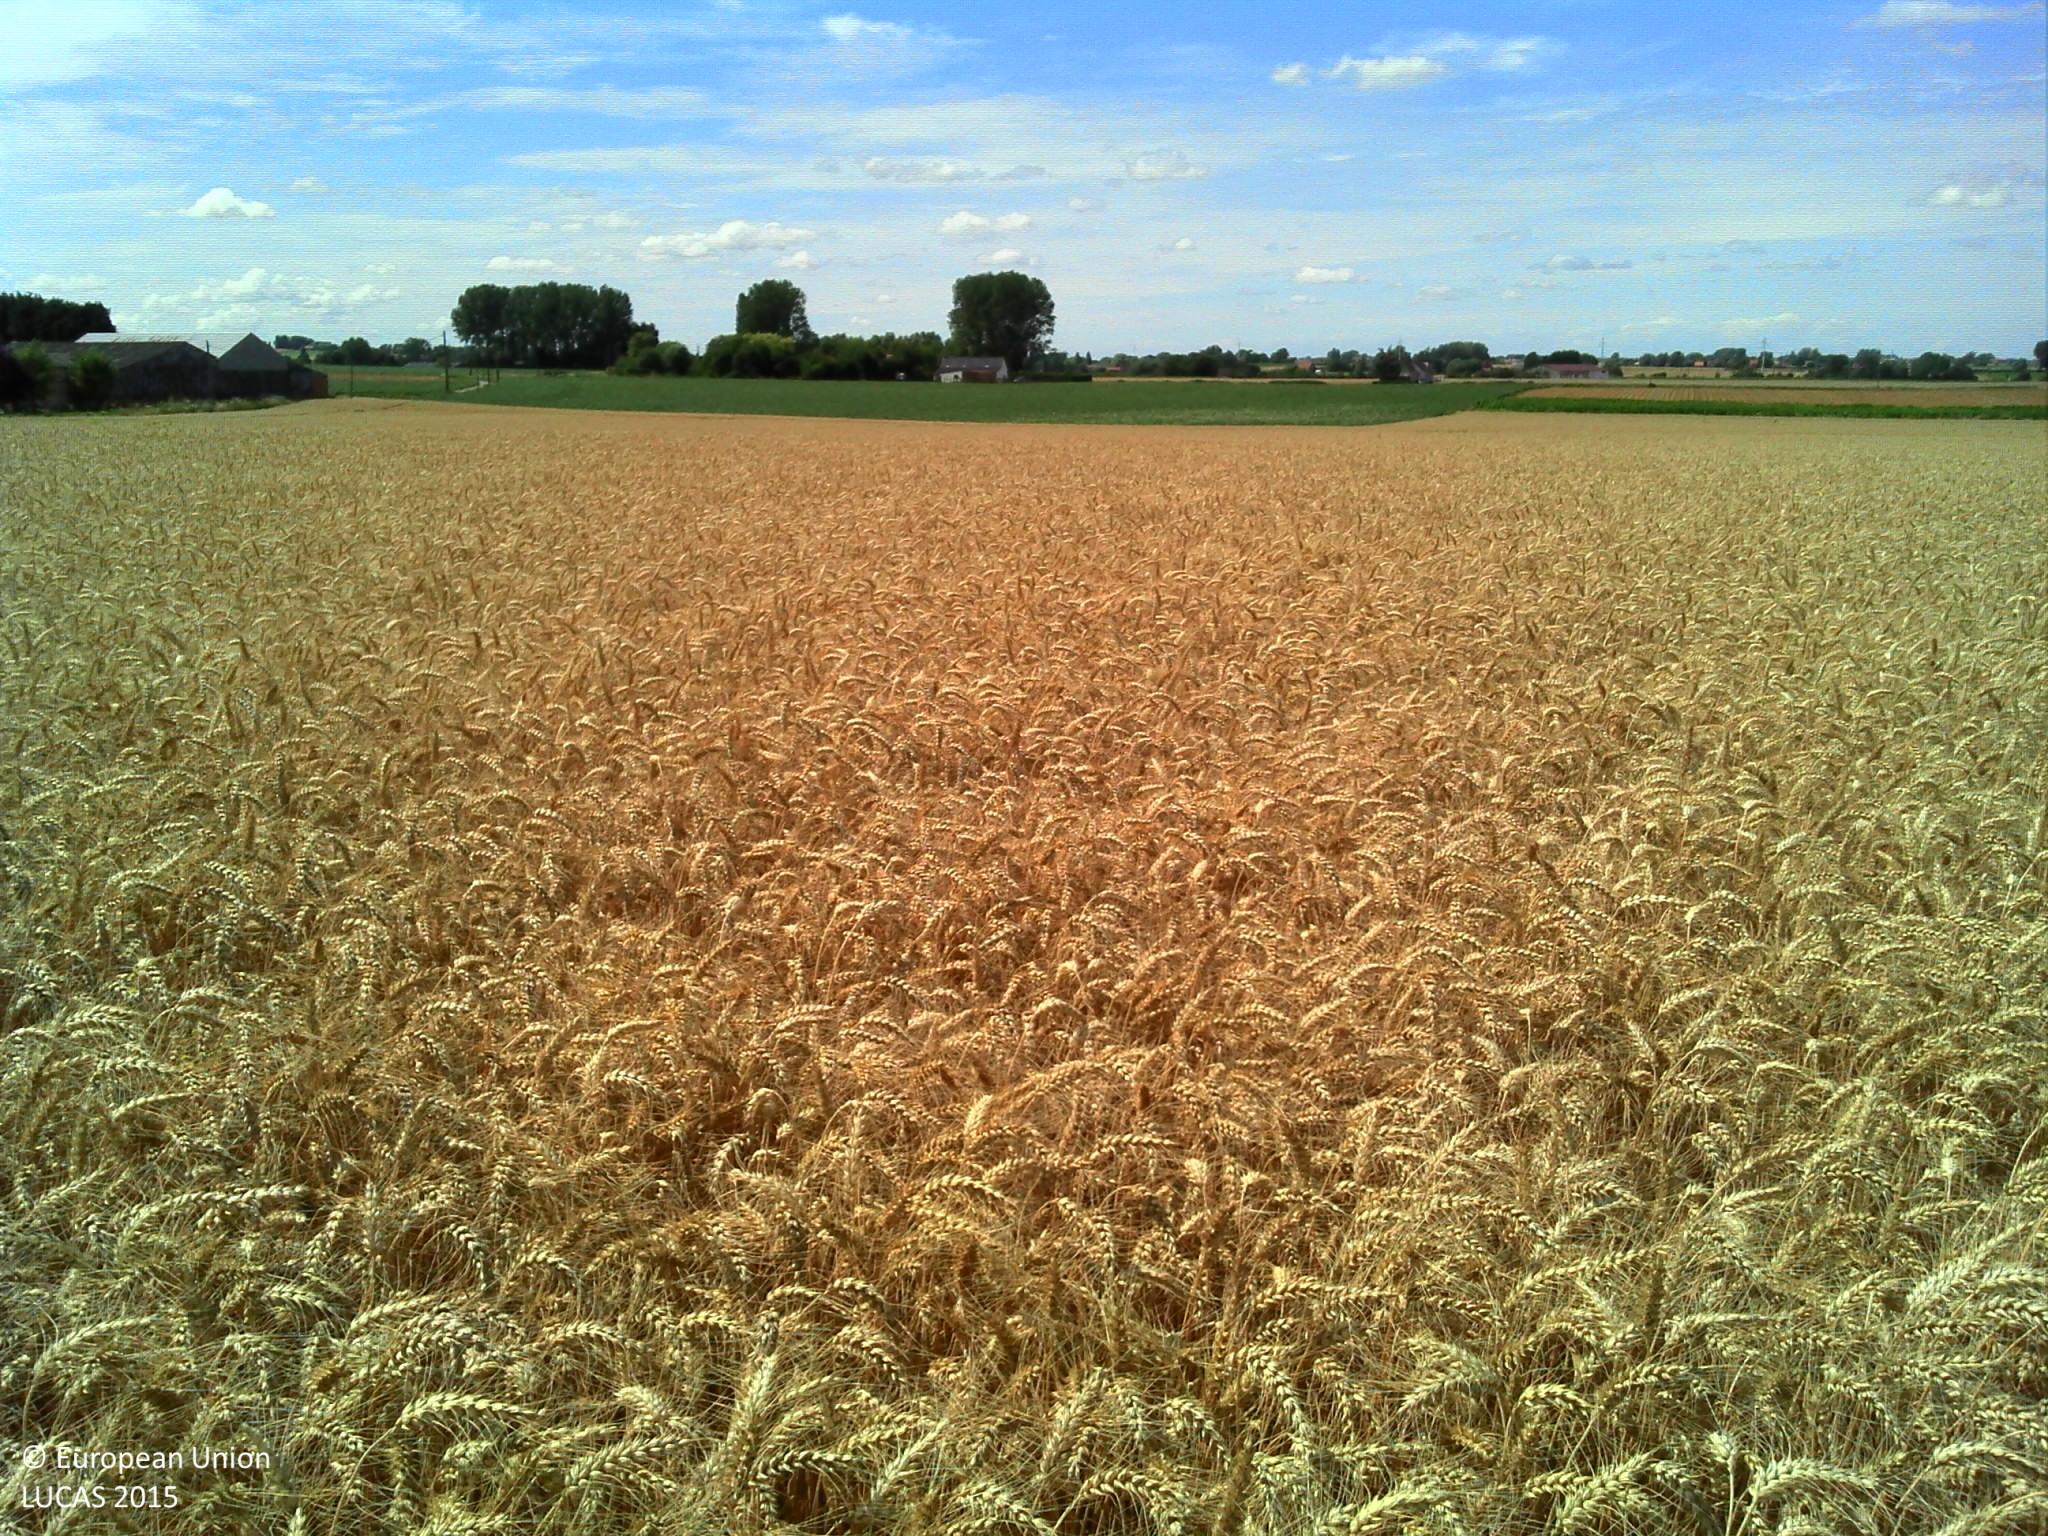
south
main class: Cropland
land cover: Common wheat
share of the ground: > 75 %
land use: Agriculture (excluding fallow land and kitchen gardens)
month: July
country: FR
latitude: 50.8168
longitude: 2.4215
